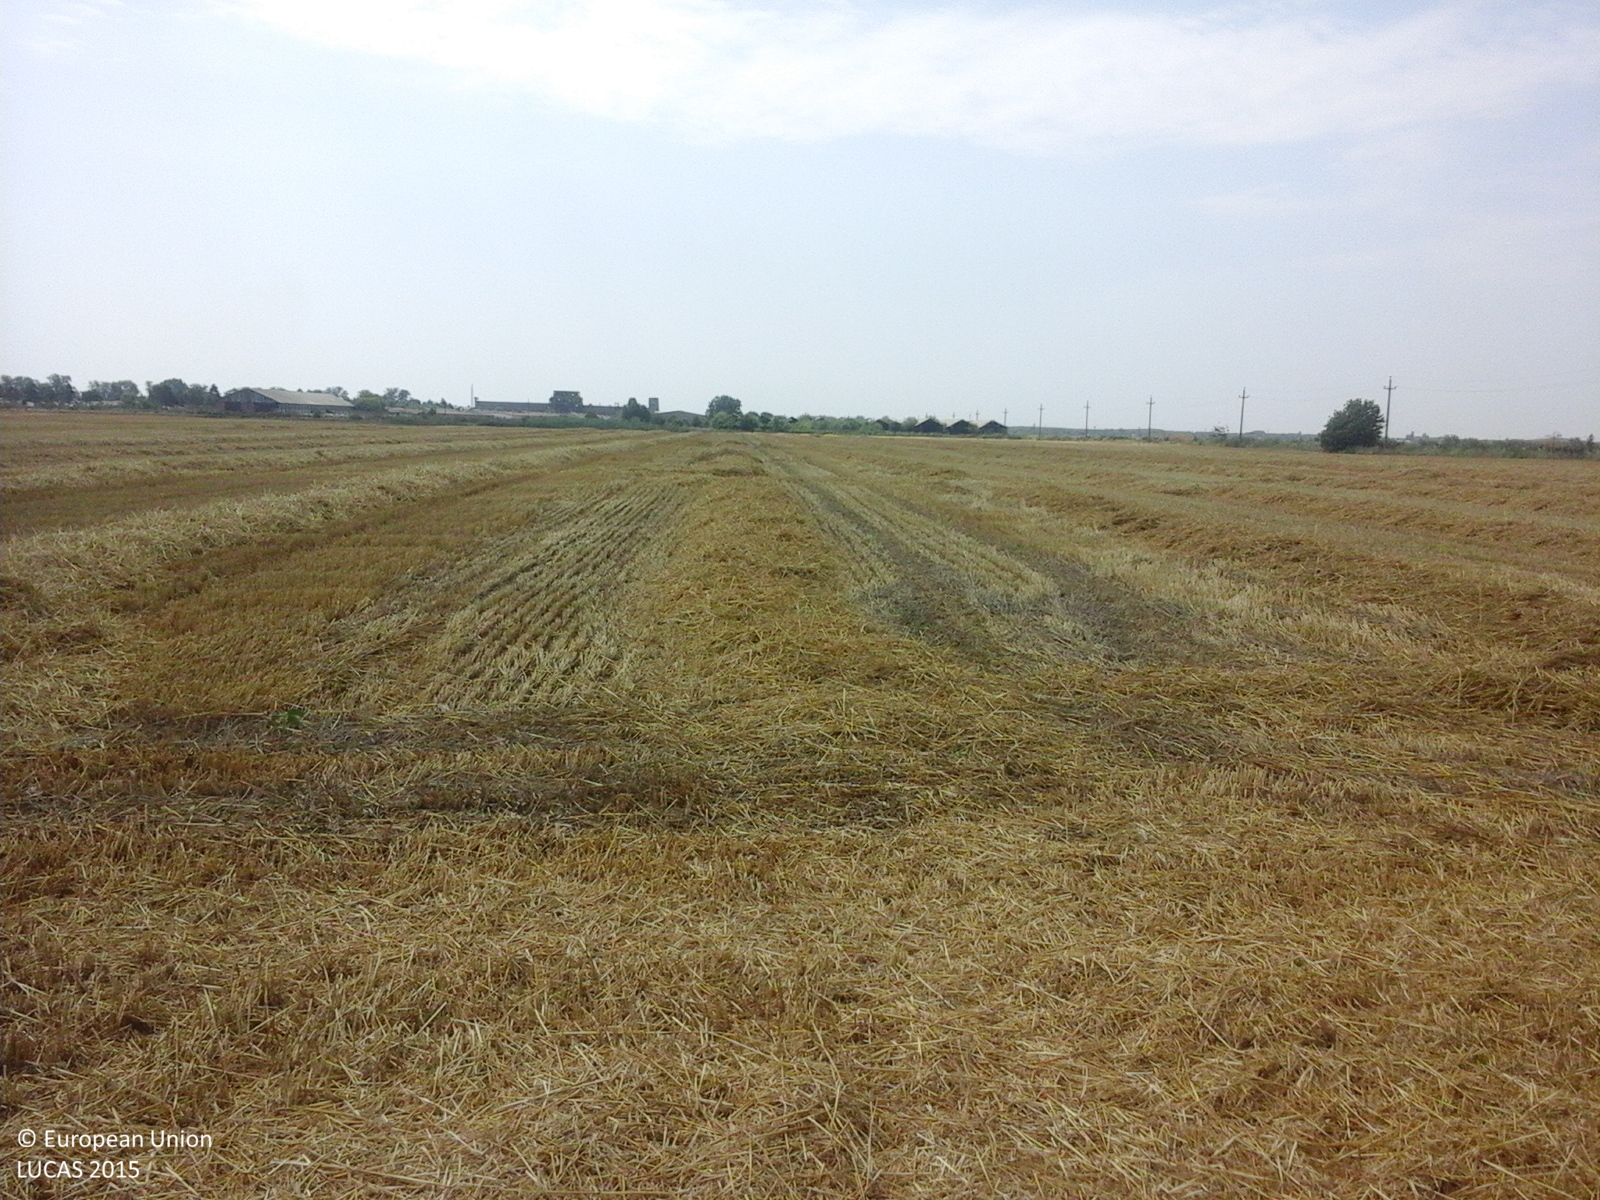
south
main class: Cropland
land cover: Common wheat
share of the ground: < 10 %
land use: Agriculture (excluding fallow land and kitchen gardens)
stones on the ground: < 10 %
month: July
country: RO
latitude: 44.6404
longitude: 27.5828
